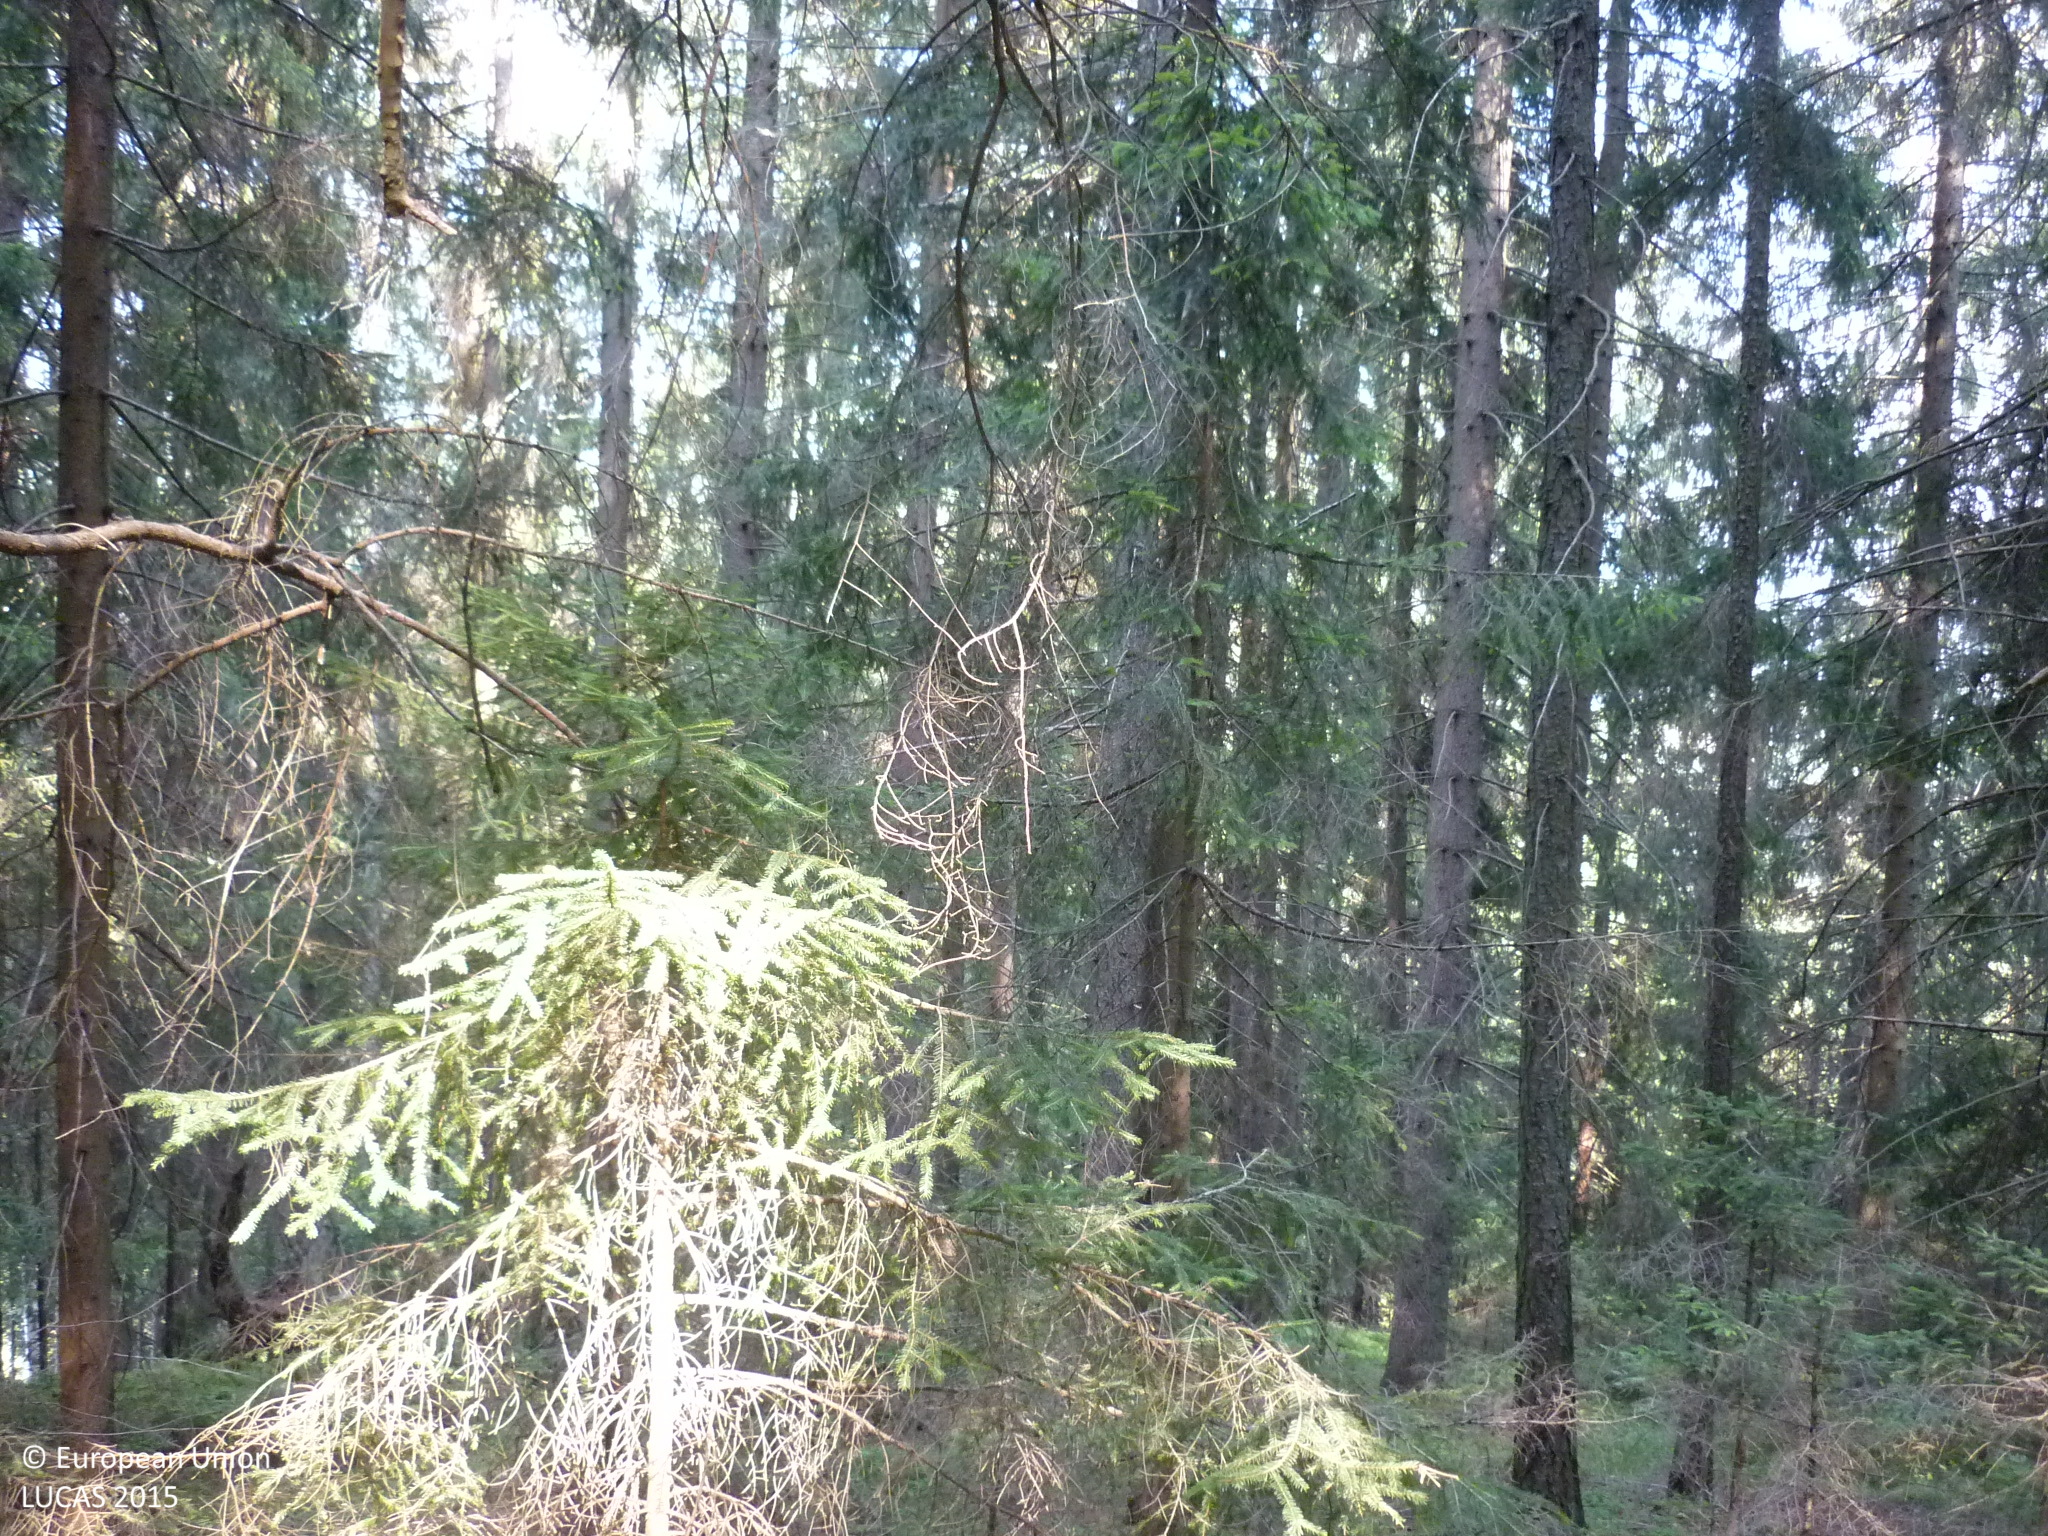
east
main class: Woodland
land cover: Spruce dominated coniferous woodland
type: alpine coniferous forest
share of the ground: > 75 %
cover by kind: coniferous forest trees 95 %, shrubs 5 %
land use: Forestry
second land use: Amenities, museums, leisure
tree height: > 5 m
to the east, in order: Spruce dominated coniferous woodland; Tracks; Spruce dominated coniferous woodland; Rivers and streams; Fences; Spruce dominated coniferous woodland; Fences; Spruce dominated coniferous woodland; Grassland without tree/shrub cover
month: July
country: AT
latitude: 47.0226
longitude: 14.7218
